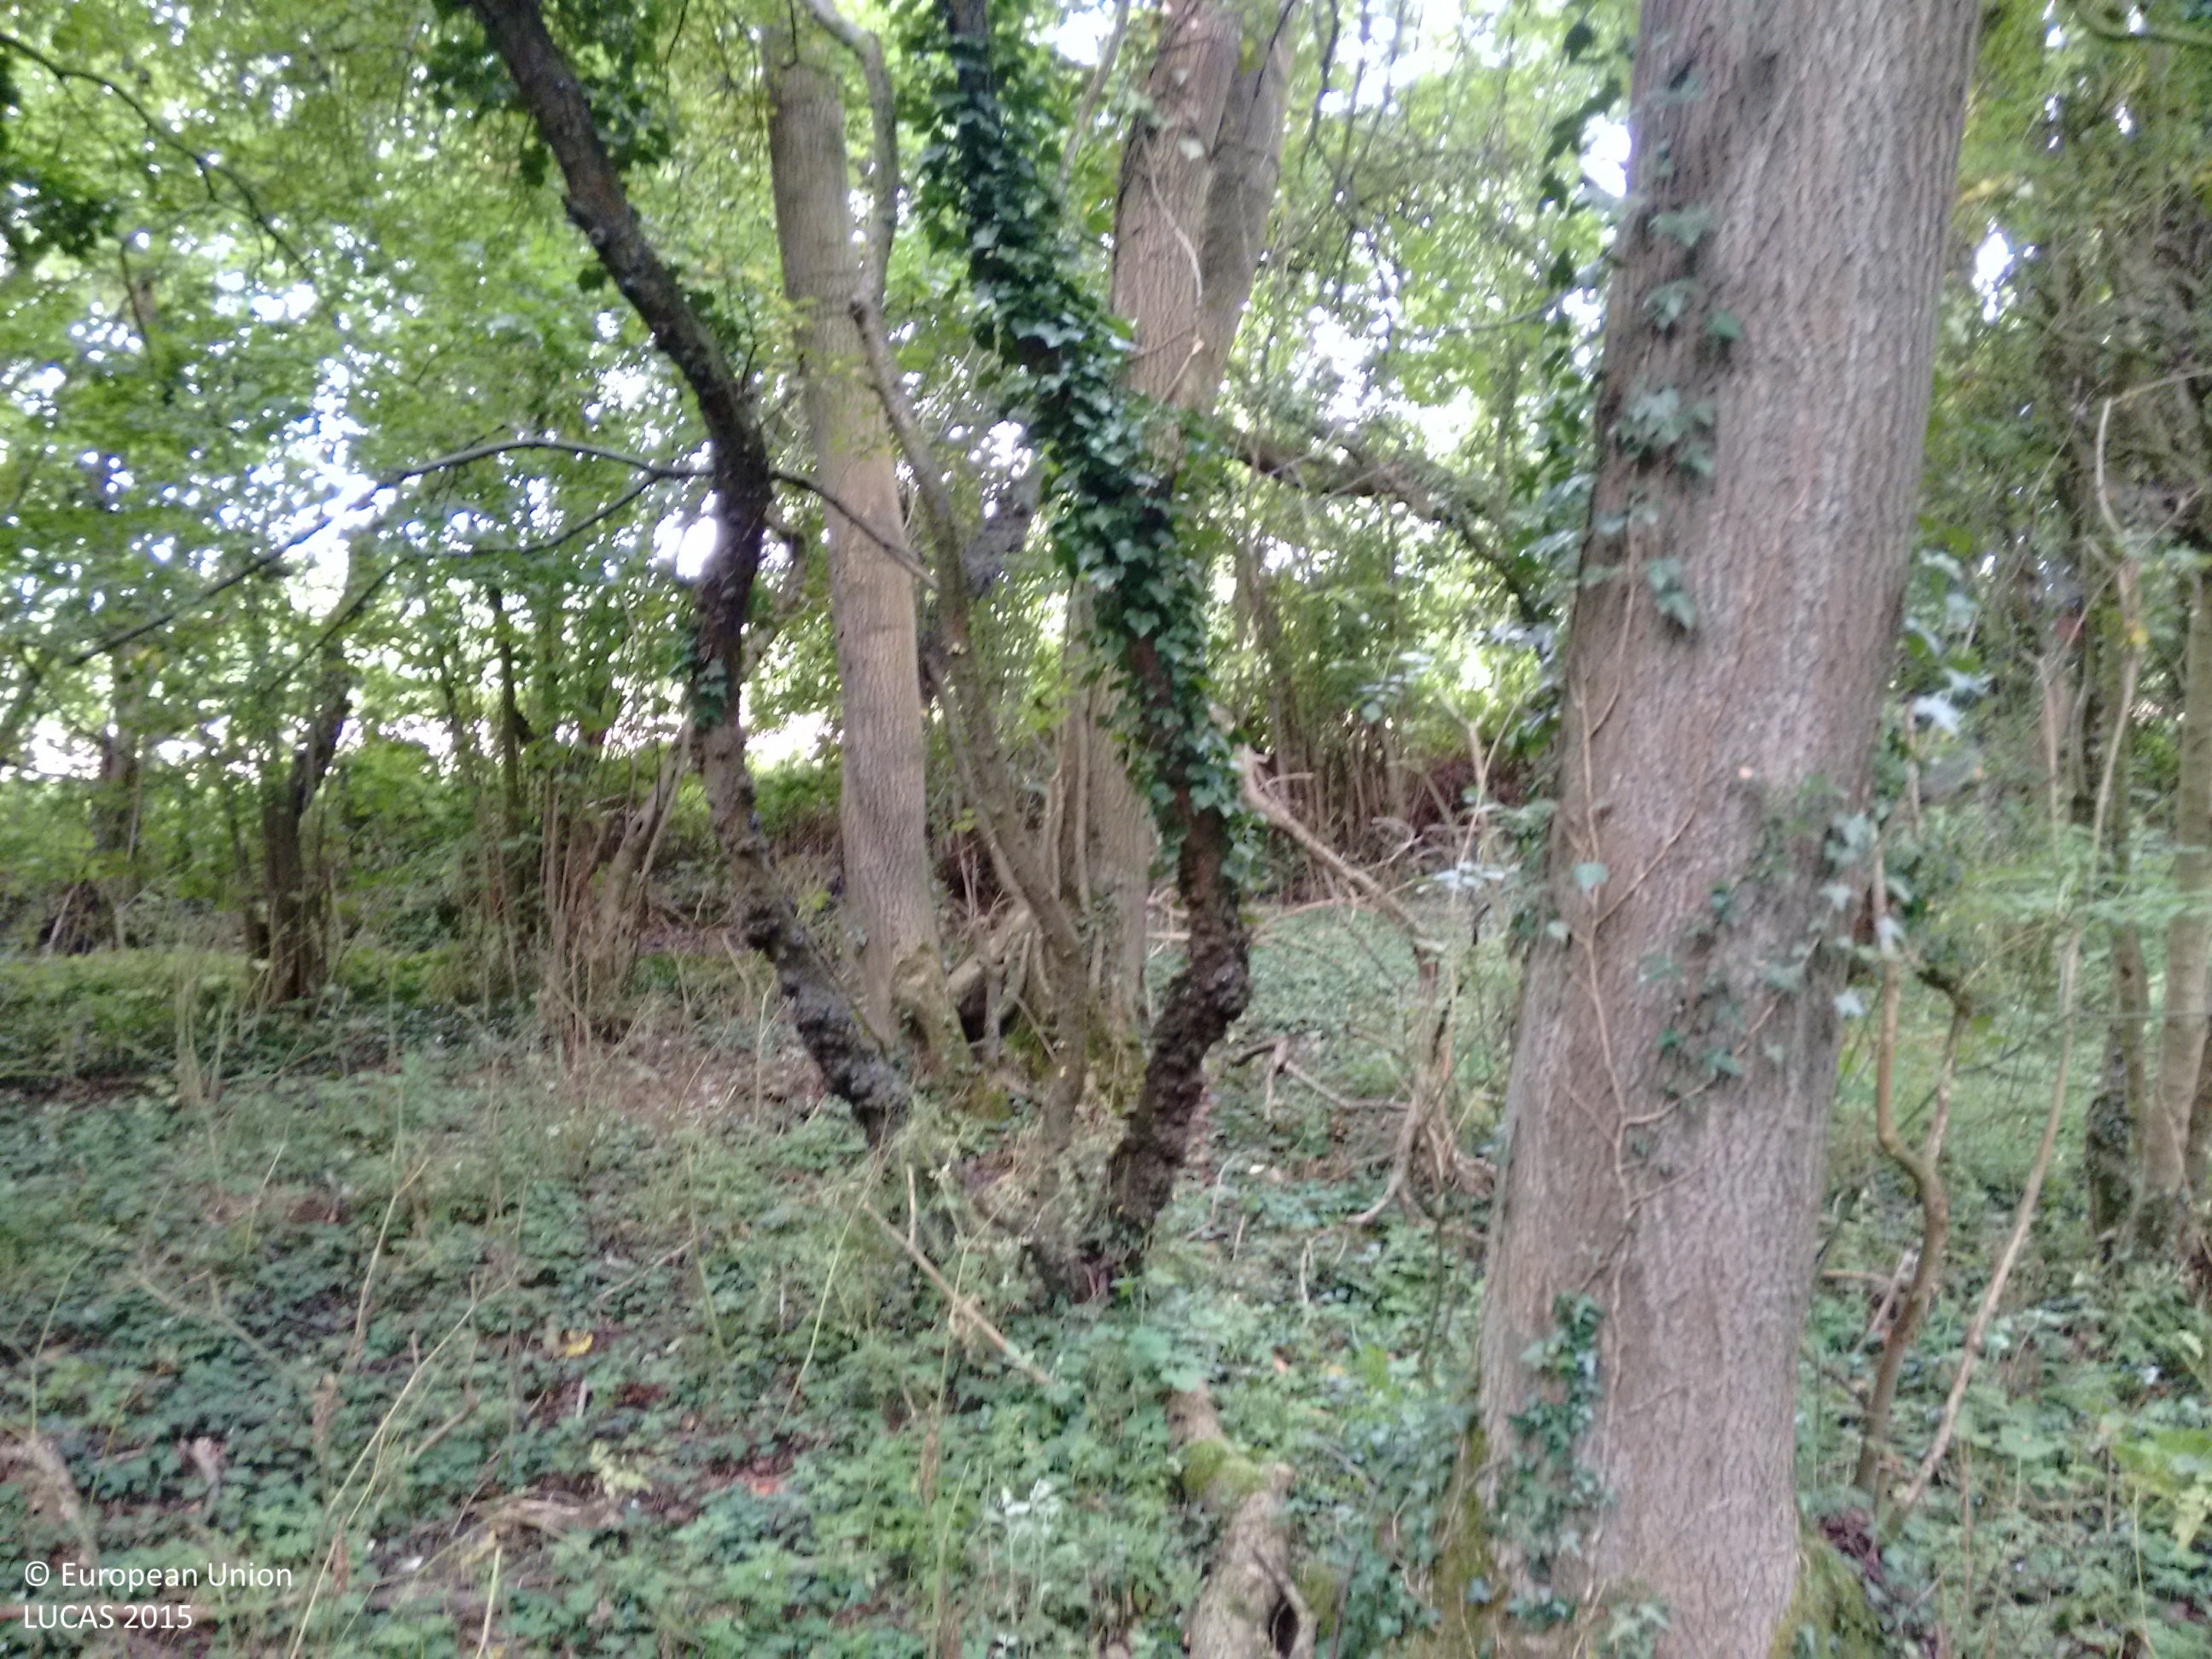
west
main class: Woodland
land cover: Broadleaved woodland
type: mesophytic deciduous forest
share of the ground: > 75 %
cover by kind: broadleaved forest trees 90 %, herbaceous plants 10 %
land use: Semi-natural and natural areas not in use
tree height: > 5 m
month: July
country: GB
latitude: 51.7317
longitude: -1.6218
